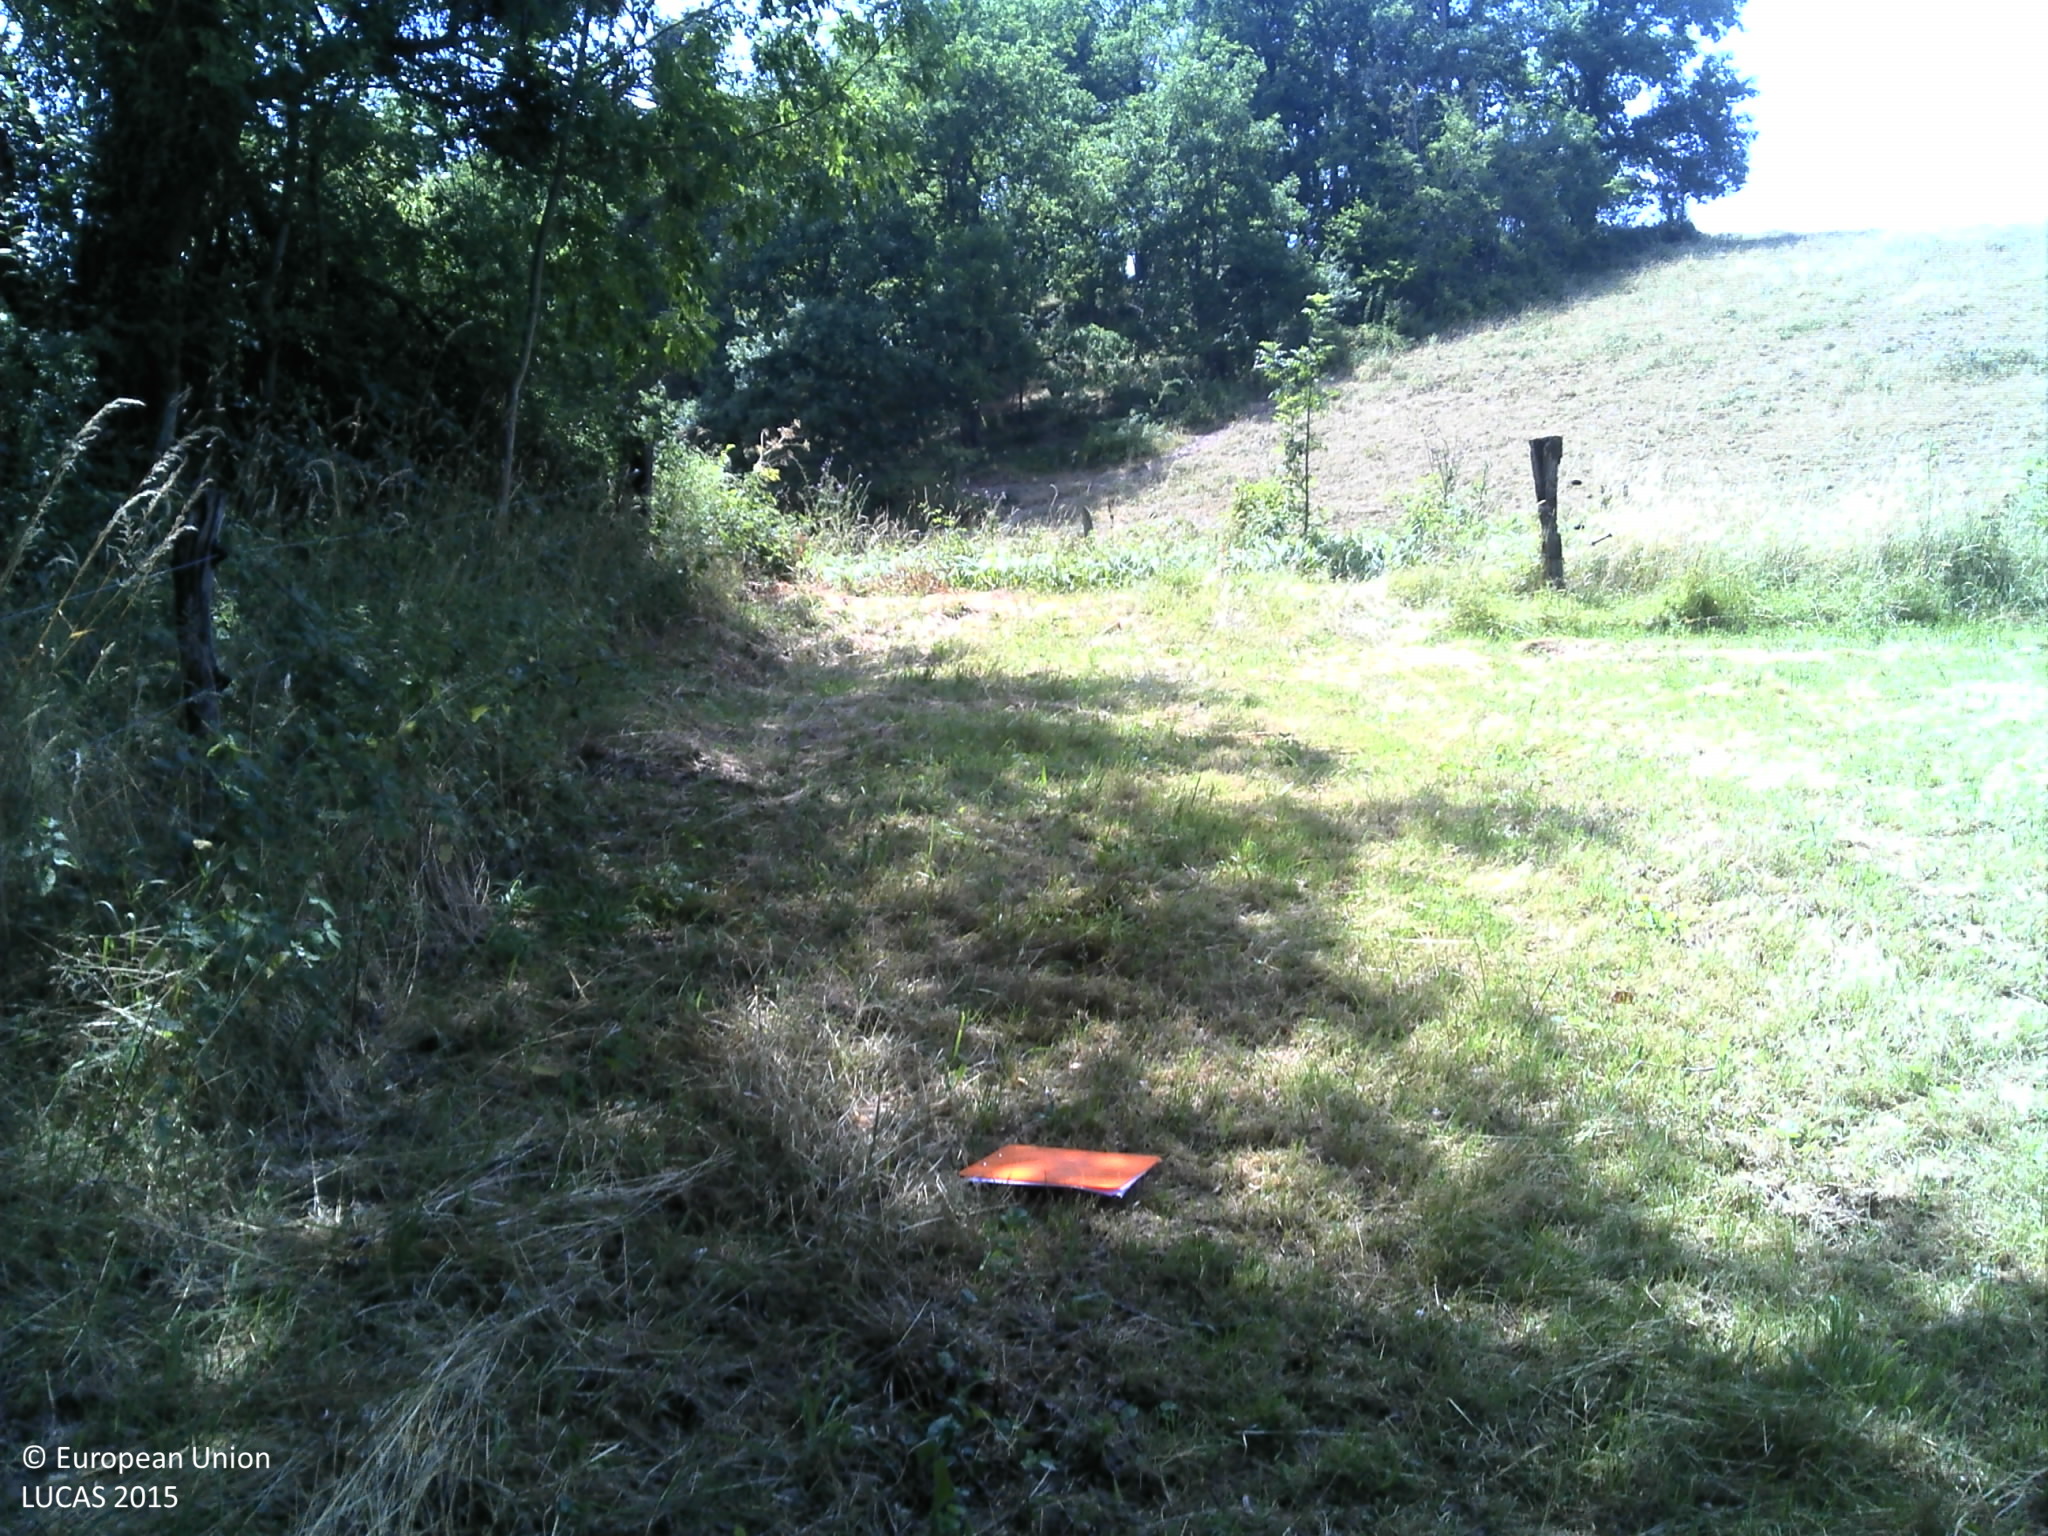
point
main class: Grassland
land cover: Grassland without tree/shrub cover
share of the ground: > 75 %
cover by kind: herbaceous plants 100 %
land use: Agriculture (excluding fallow land and kitchen gardens)
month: July
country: FR
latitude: 45.7142
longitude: 3.4107
